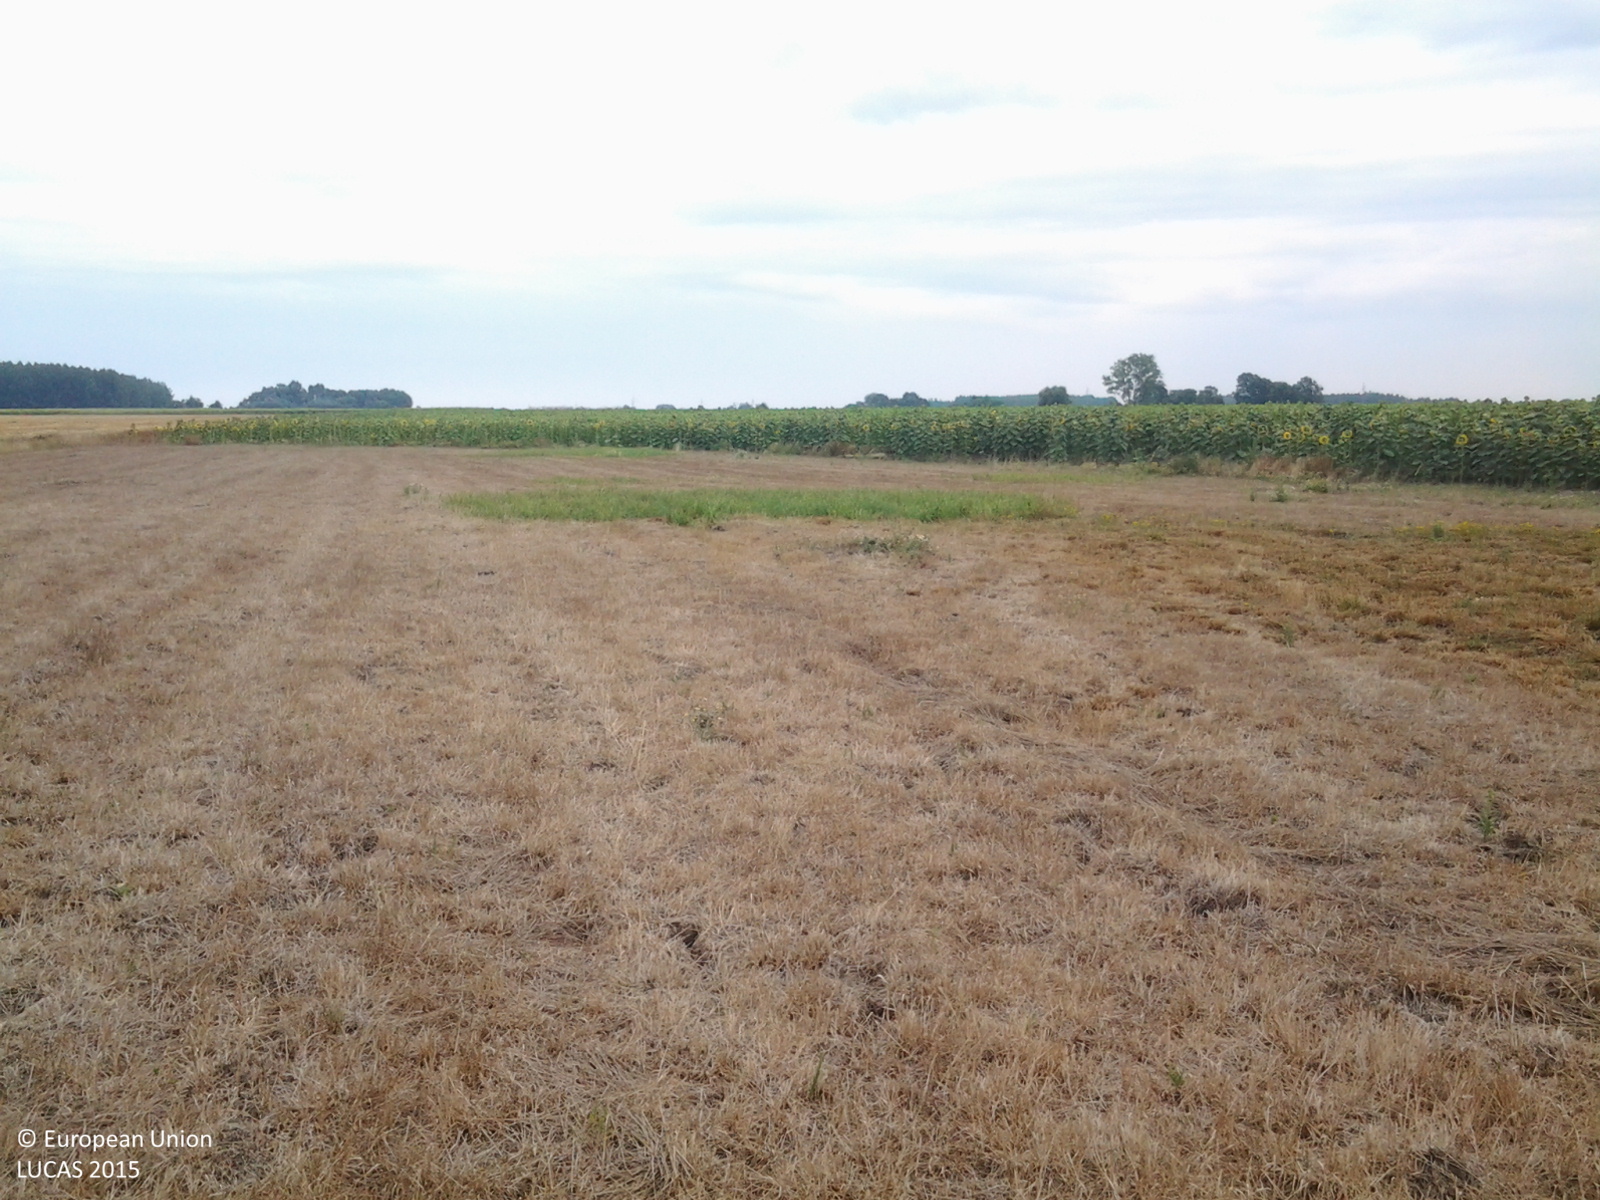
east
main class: Grassland
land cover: Grassland without tree/shrub cover
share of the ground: > 75 %
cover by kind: herbaceous plants 100 %
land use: Agriculture (excluding fallow land and kitchen gardens)
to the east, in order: Grassland without tree/shrub cover; Sunflower
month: August
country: HU
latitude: 47.0322
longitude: 21.2090
